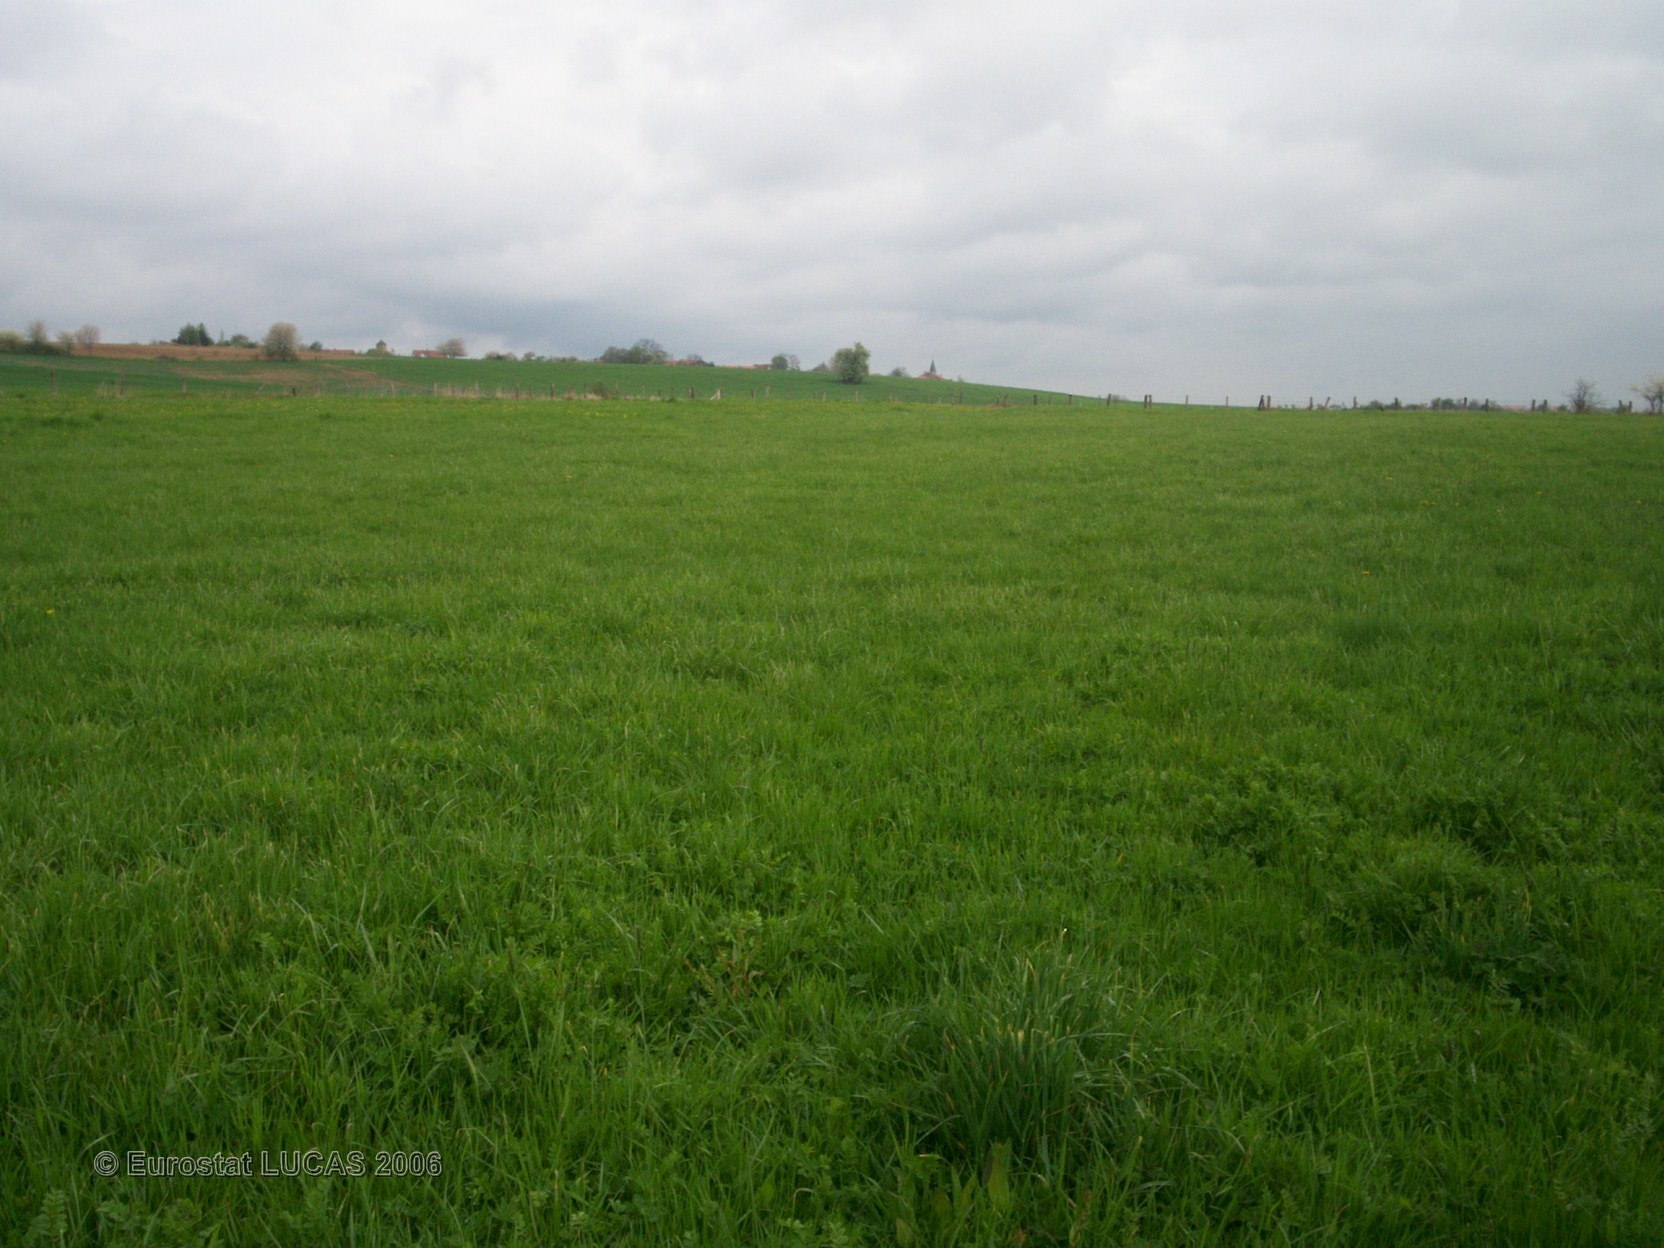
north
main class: Grassland
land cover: Grassland without tree/shrub cover
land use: Agriculture (excluding fallow land and kitchen gardens)
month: April
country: FR
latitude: 48.8058
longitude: 6.7462
